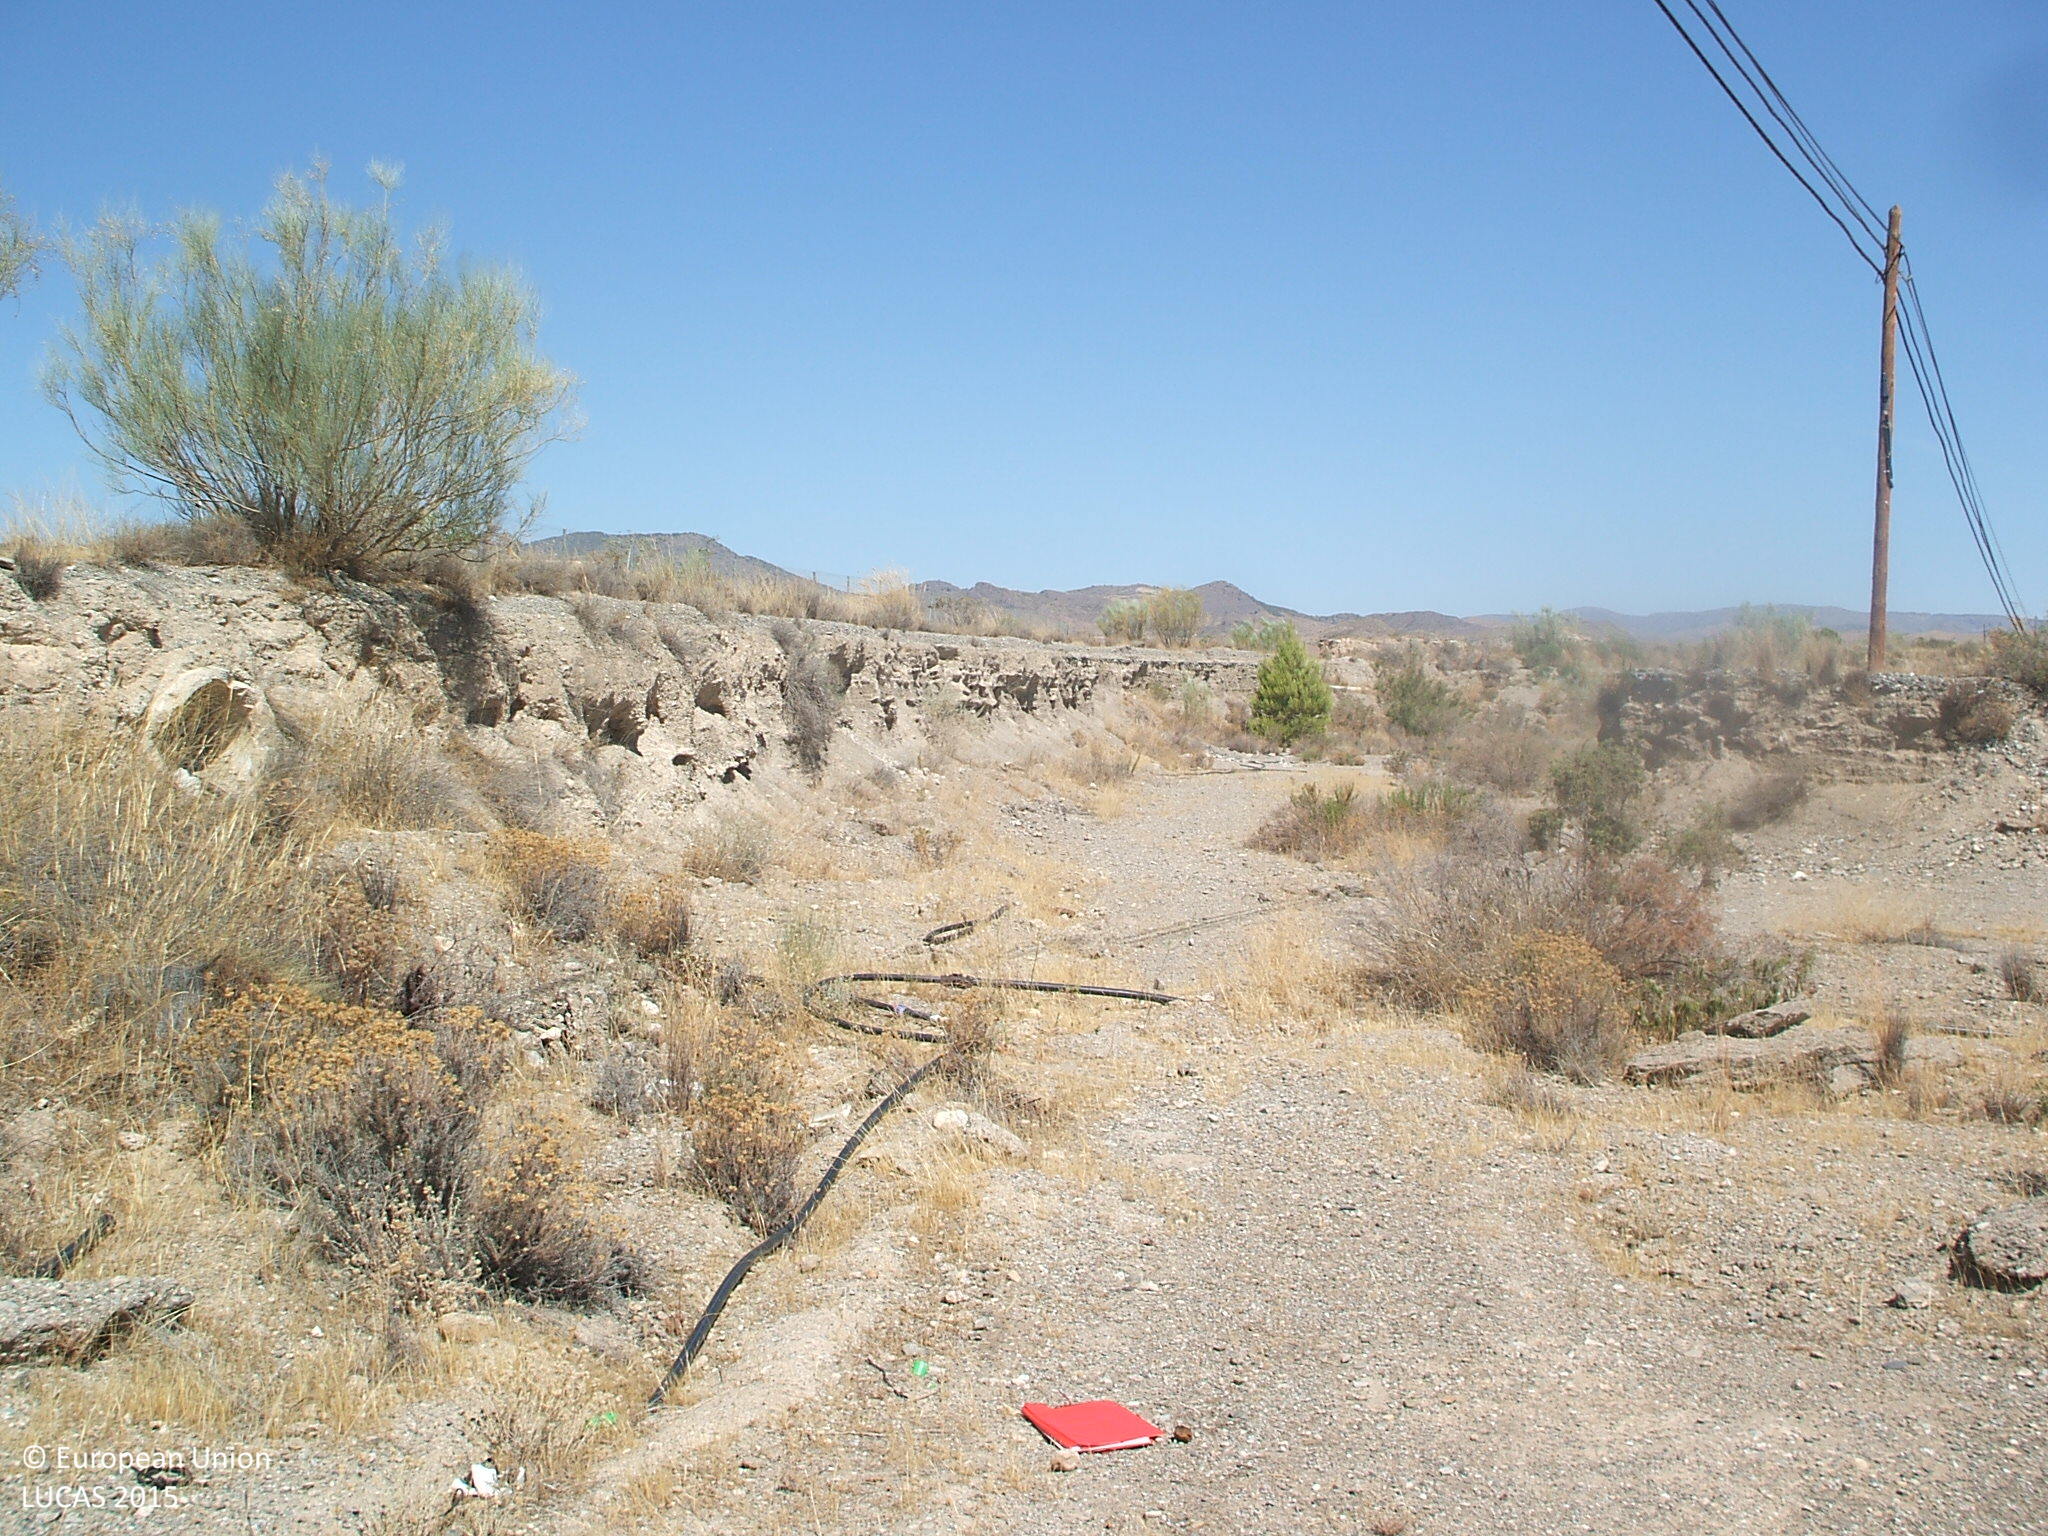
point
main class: Shrubland
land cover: Shrubland without tree cover
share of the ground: 10 - 25 %
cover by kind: consolidated bare surface 60 %, shrubs 20 %, herbaceous plants 20 %
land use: Semi-natural and natural areas not in use
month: July
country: ES
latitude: 37.3787
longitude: -2.2121
